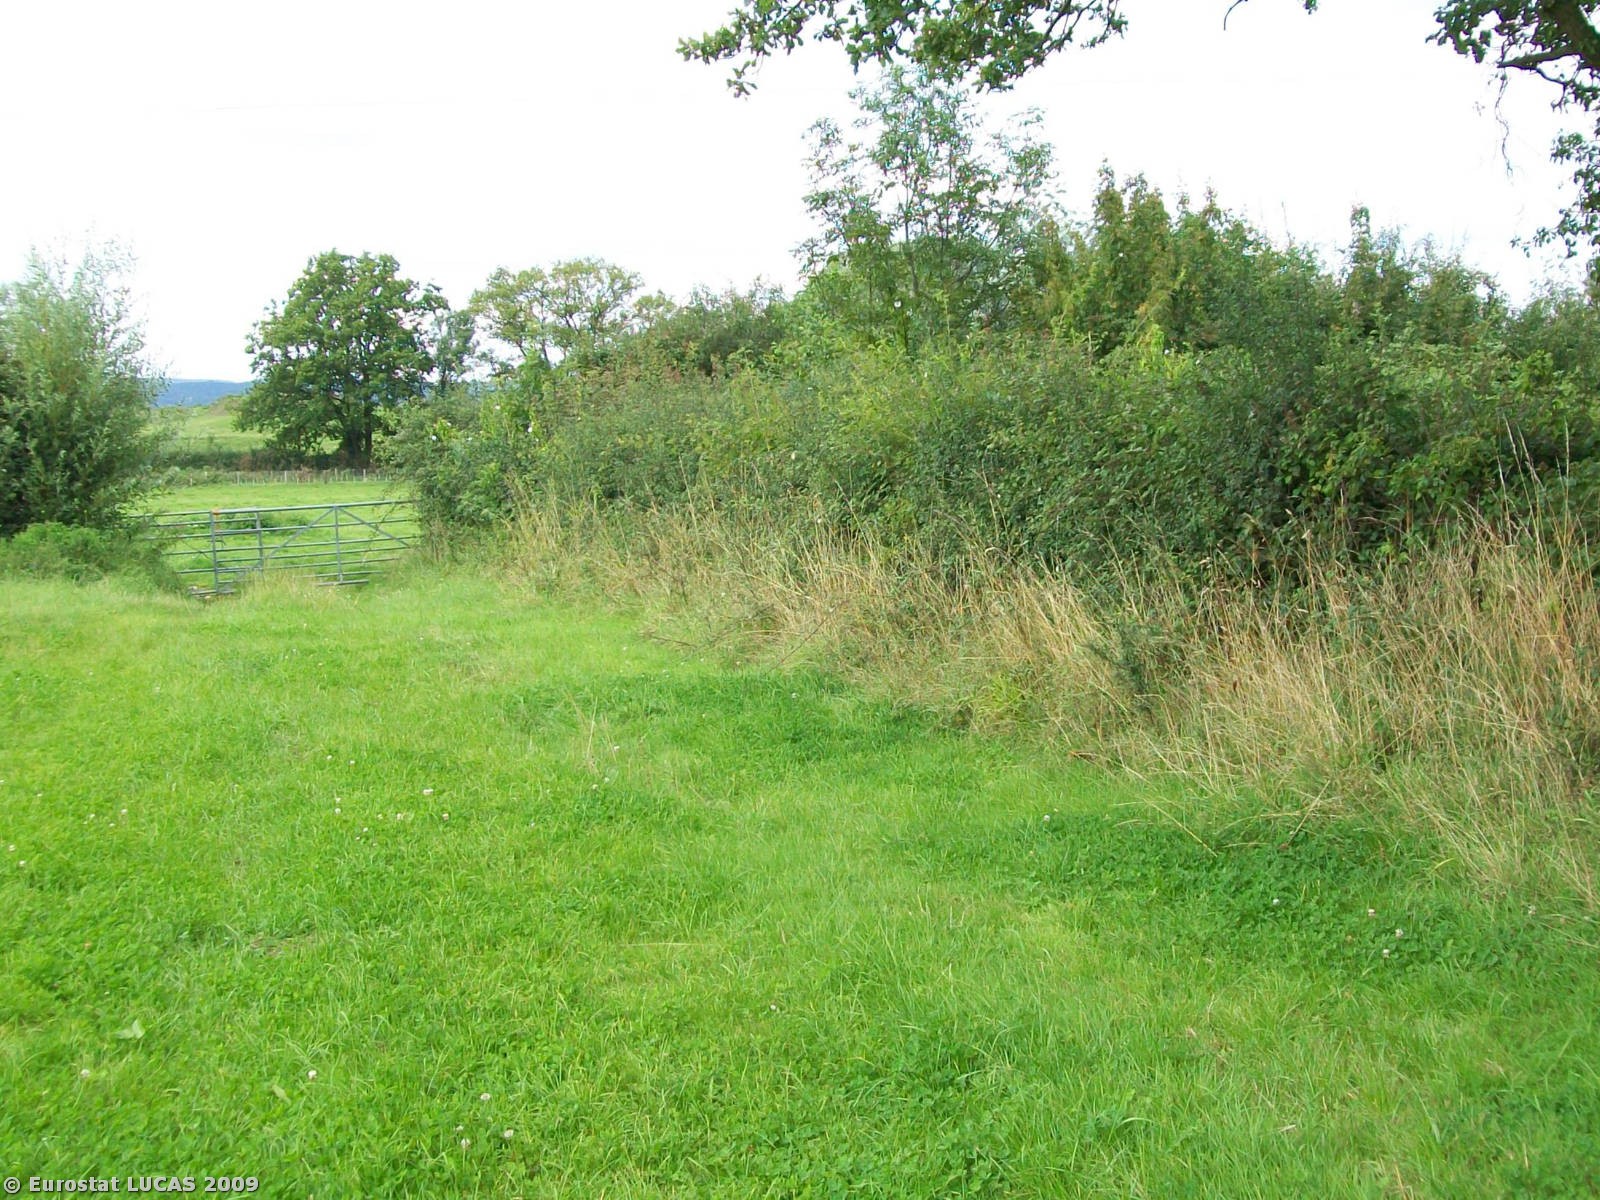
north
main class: Grassland
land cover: Grassland without tree/shrub cover
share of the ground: > 75 %
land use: Agriculture (excluding fallow land and kitchen gardens)
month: August
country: GB
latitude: 51.7965
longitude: -2.4044
